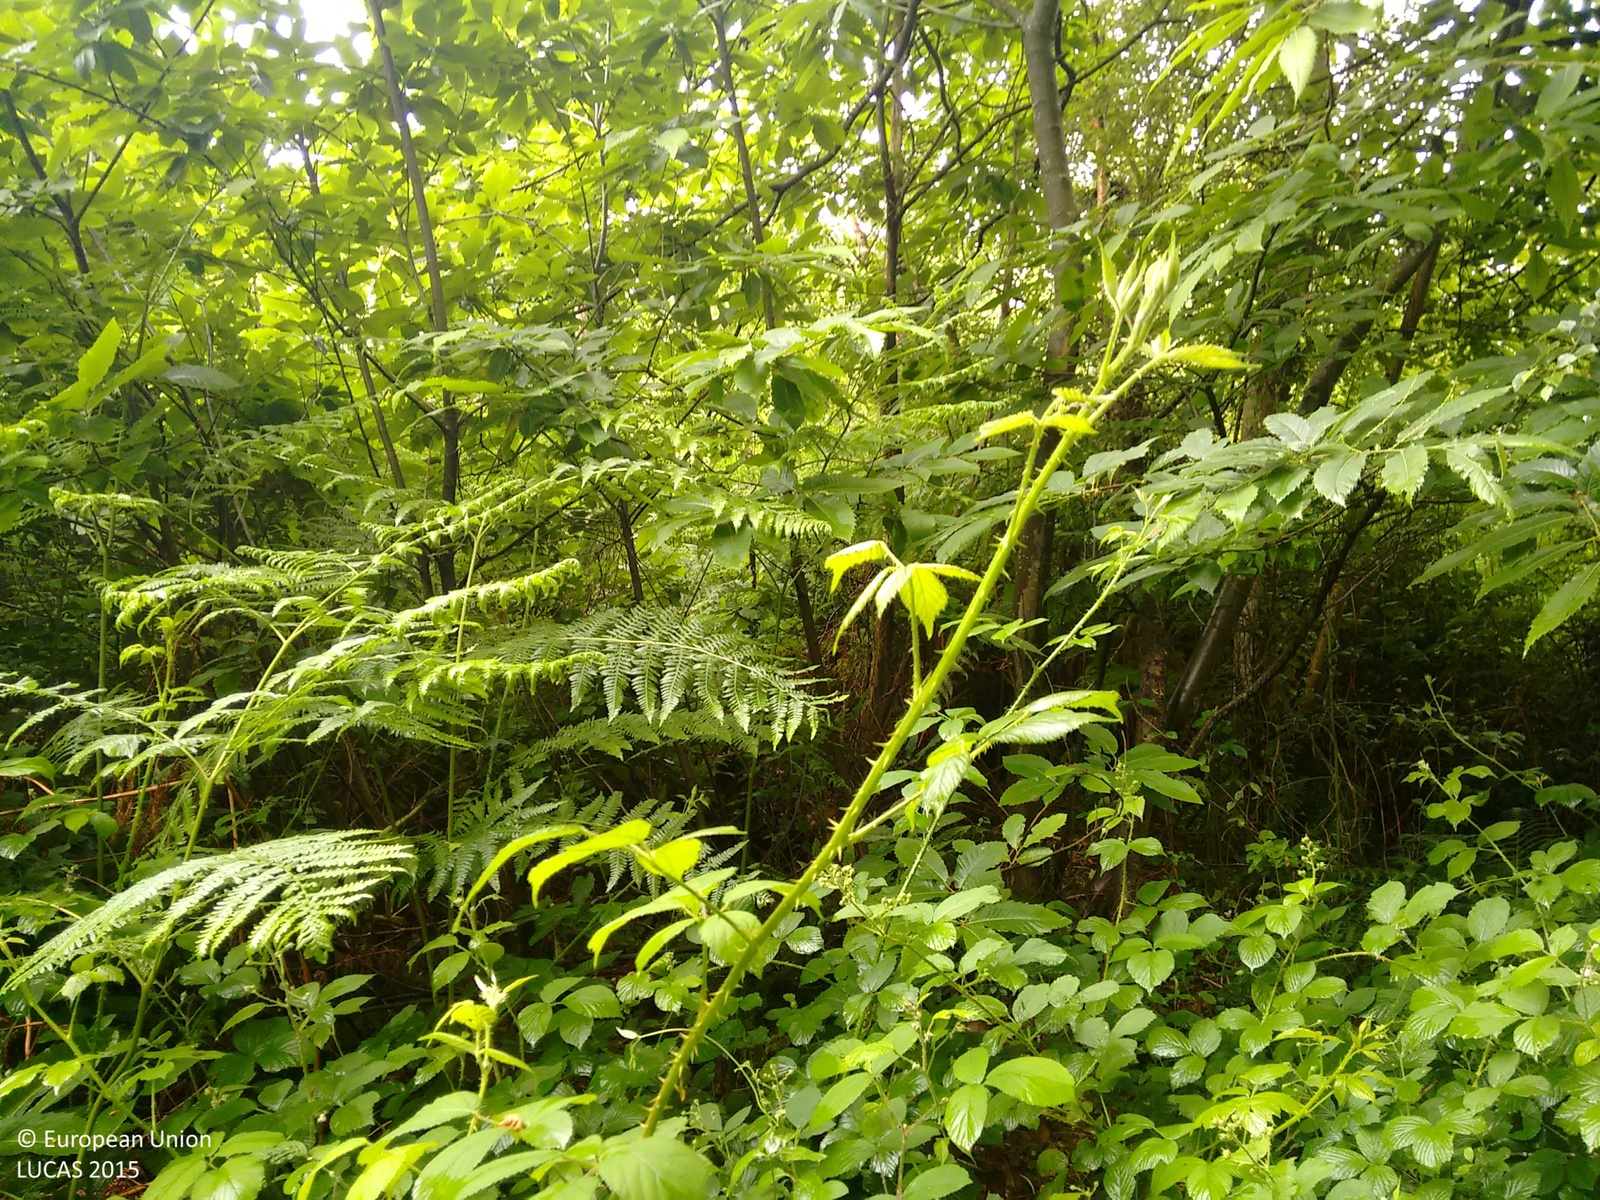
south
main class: Woodland
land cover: Broadleaved woodland
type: mesophytic deciduous forest
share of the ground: > 75 %
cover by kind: broadleaved forest trees 70 %, shrubs 30 %
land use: Forestry
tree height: > 5 m
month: June
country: GB
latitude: 50.8858
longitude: 0.4335
